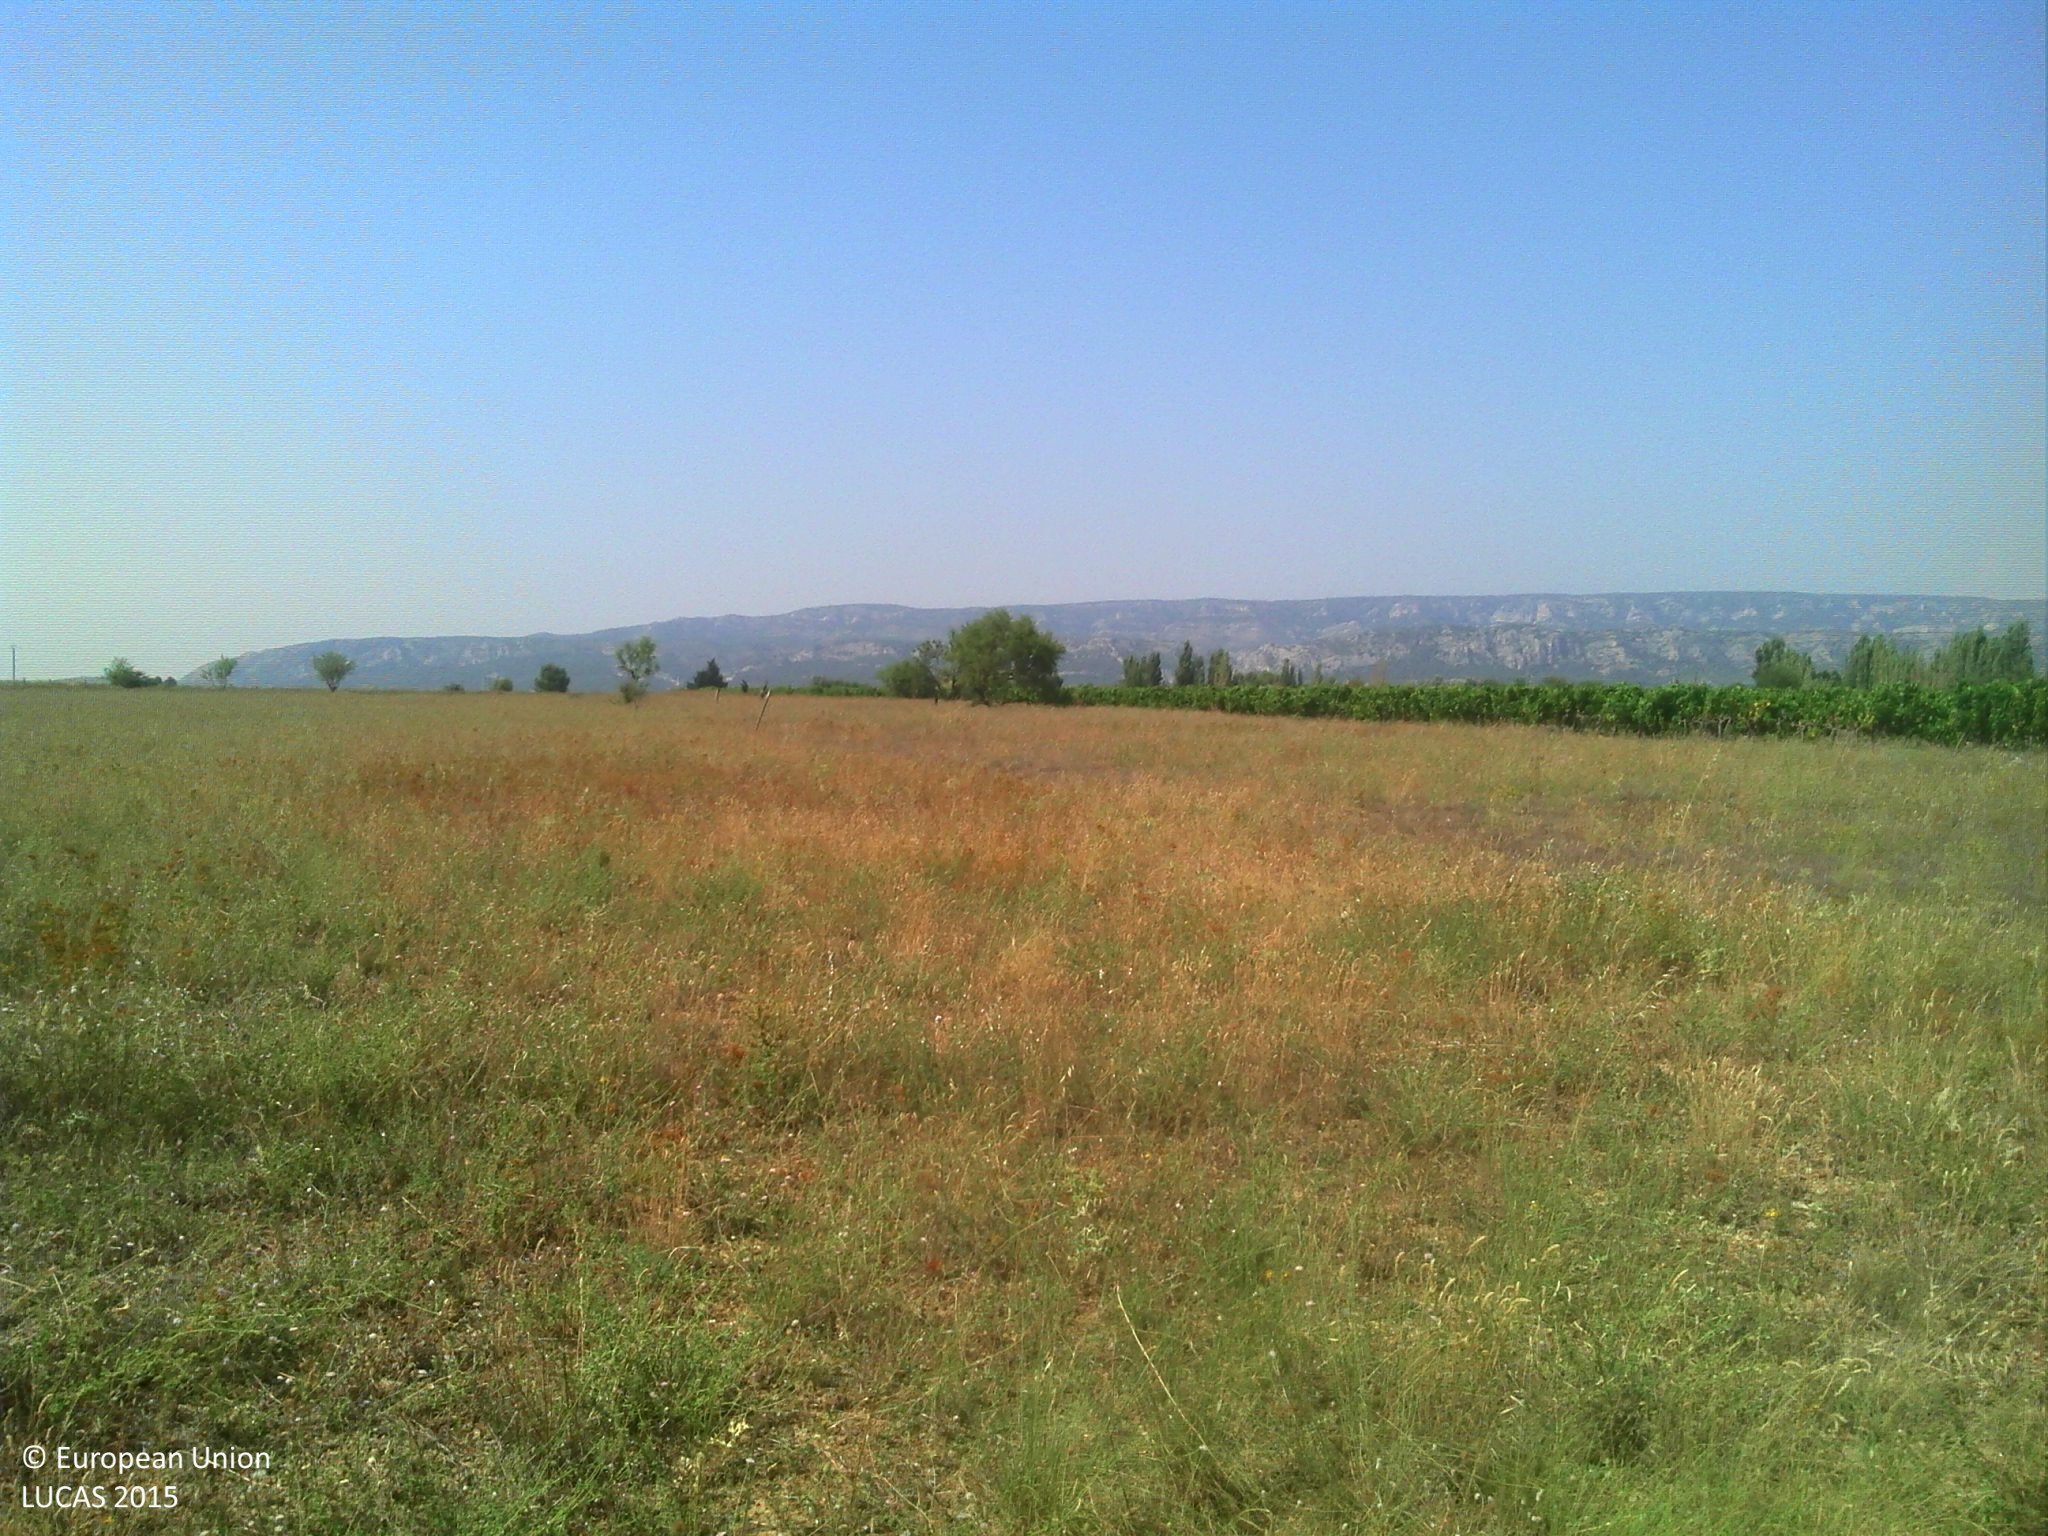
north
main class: Grassland
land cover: Grassland without tree/shrub cover
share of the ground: > 75 %
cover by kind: herbaceous plants 100 %
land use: Agriculture (excluding fallow land and kitchen gardens)
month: July
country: FR
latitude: 43.7135
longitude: 5.1564
